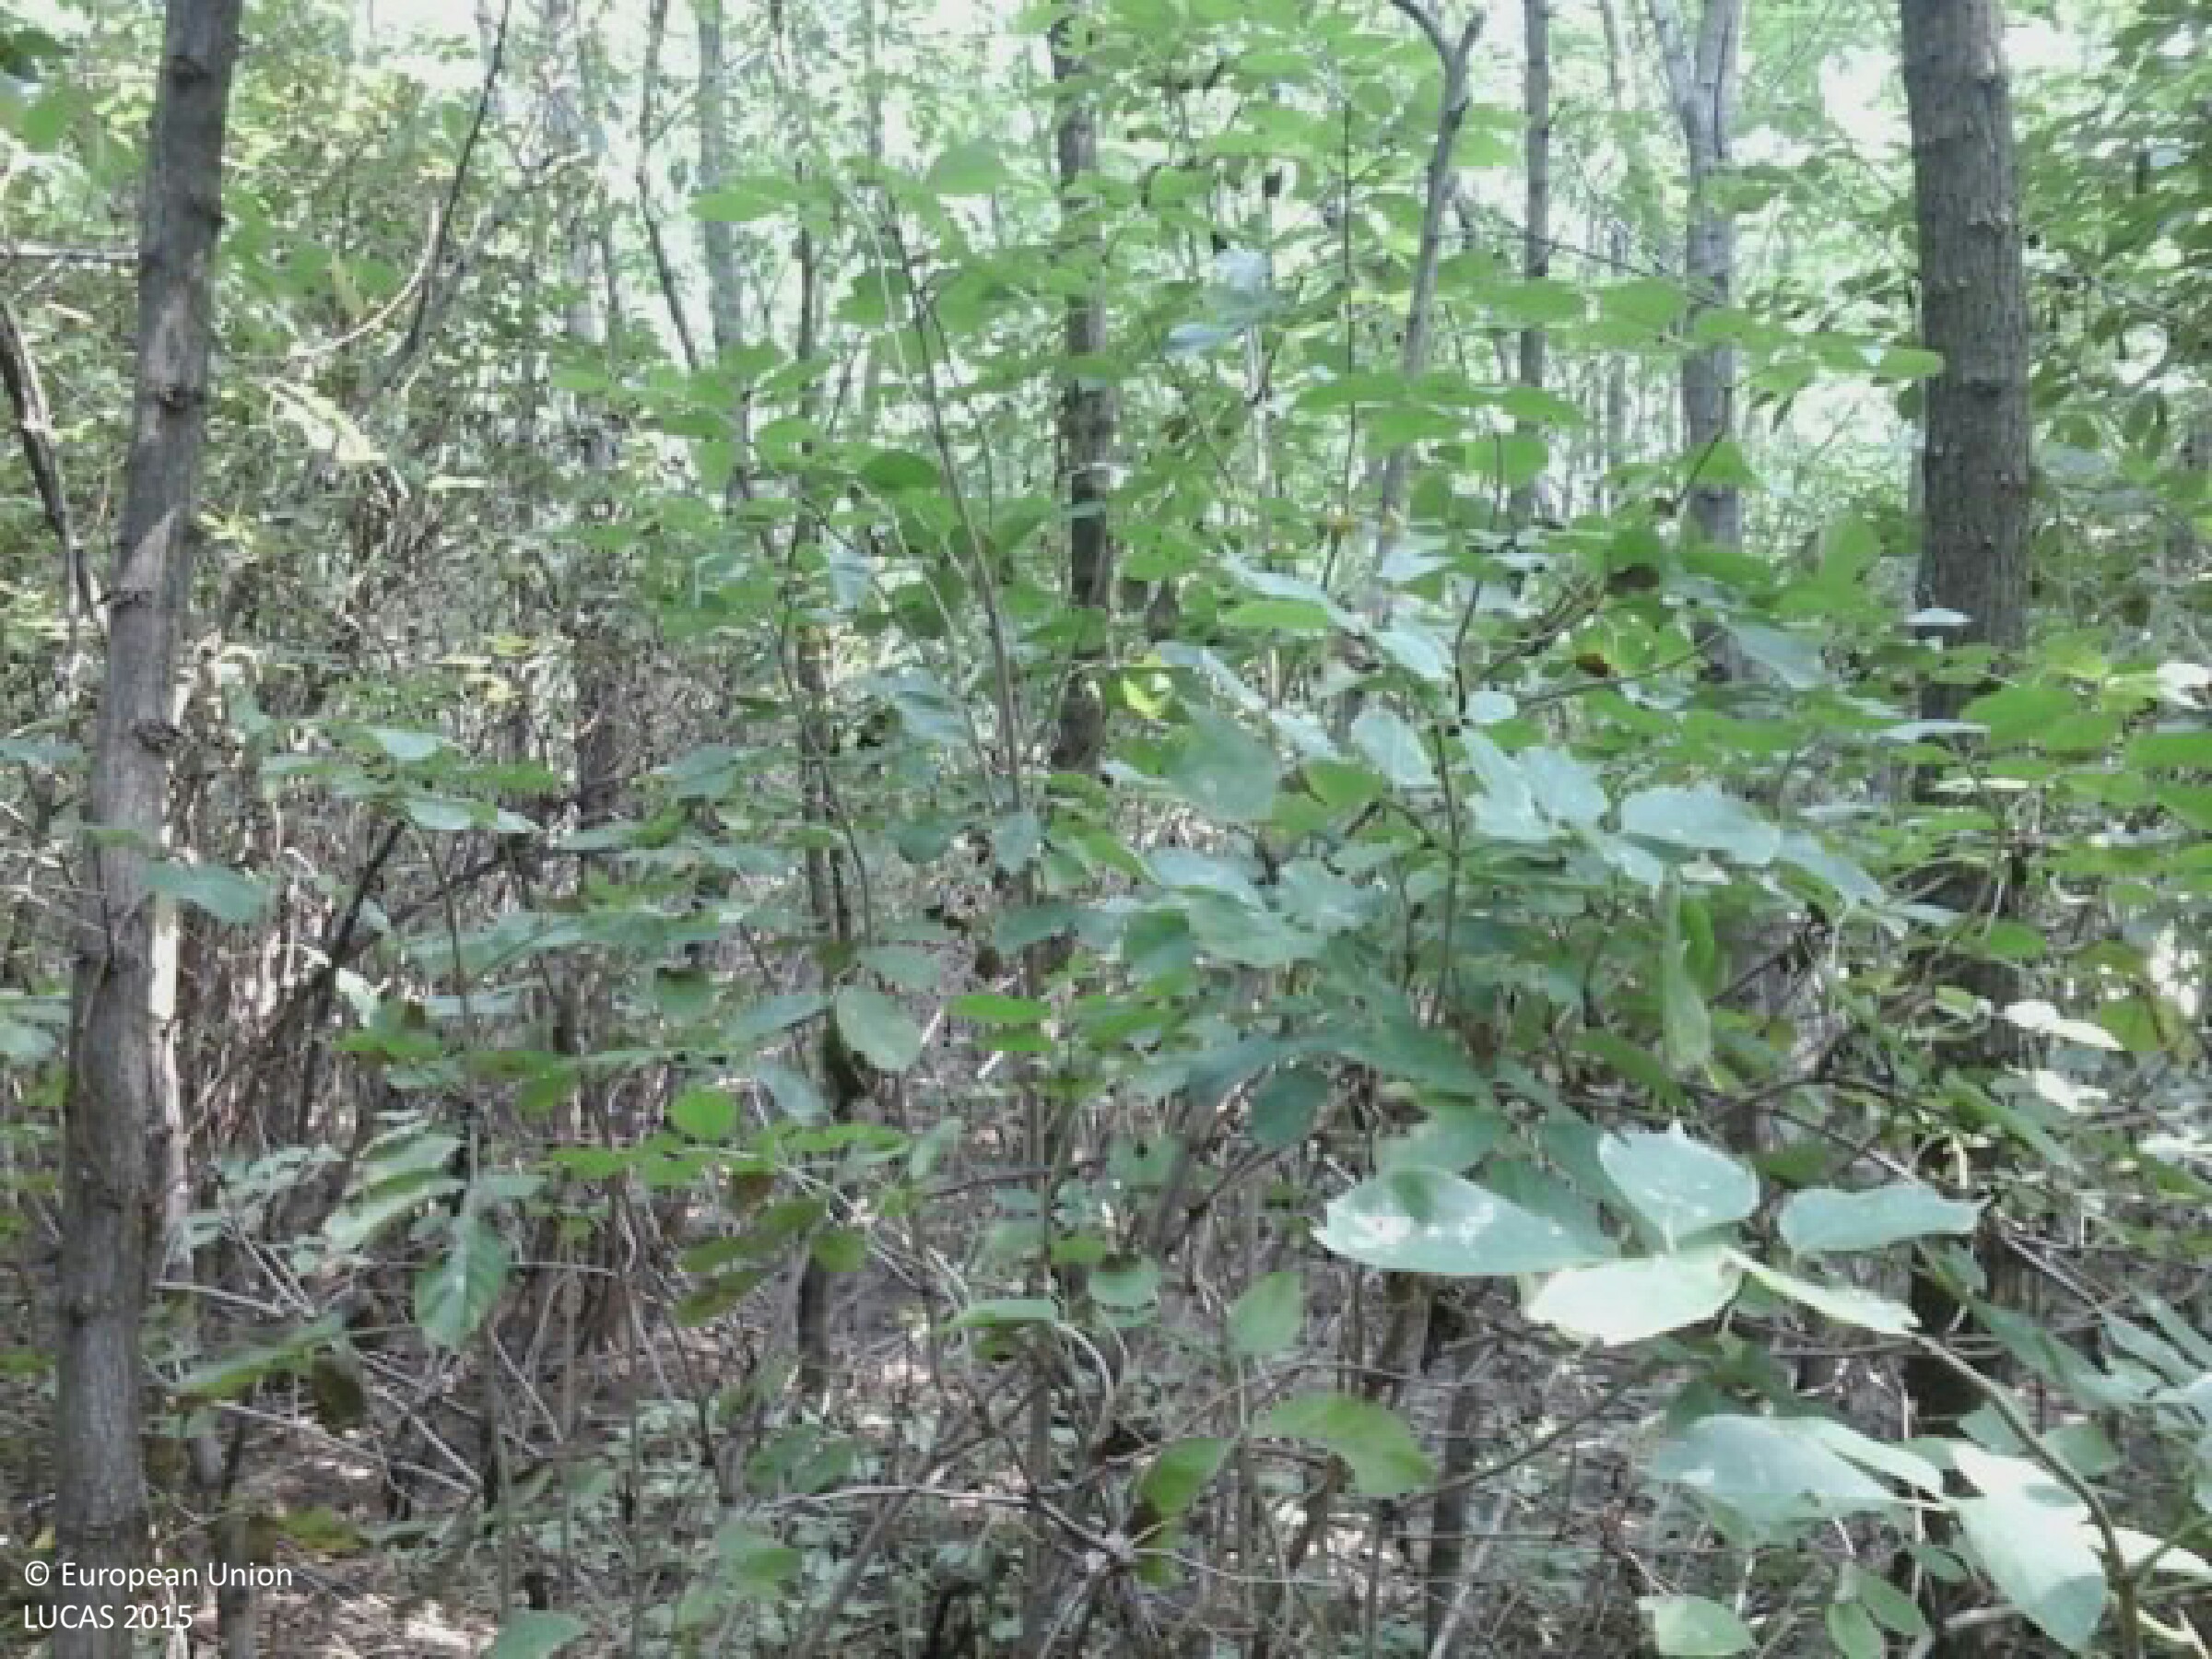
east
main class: Woodland
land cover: Broadleaved woodland
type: exotic forest
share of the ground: > 75 %
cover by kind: broadleaved forest trees 90 %, shrubs 5 %, herbaceous plants 5 %
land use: Forestry
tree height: > 5 m
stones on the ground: < 10 %
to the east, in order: Broadleaved woodland; Common wheat
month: August
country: HU
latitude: 46.4145
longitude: 17.9821
